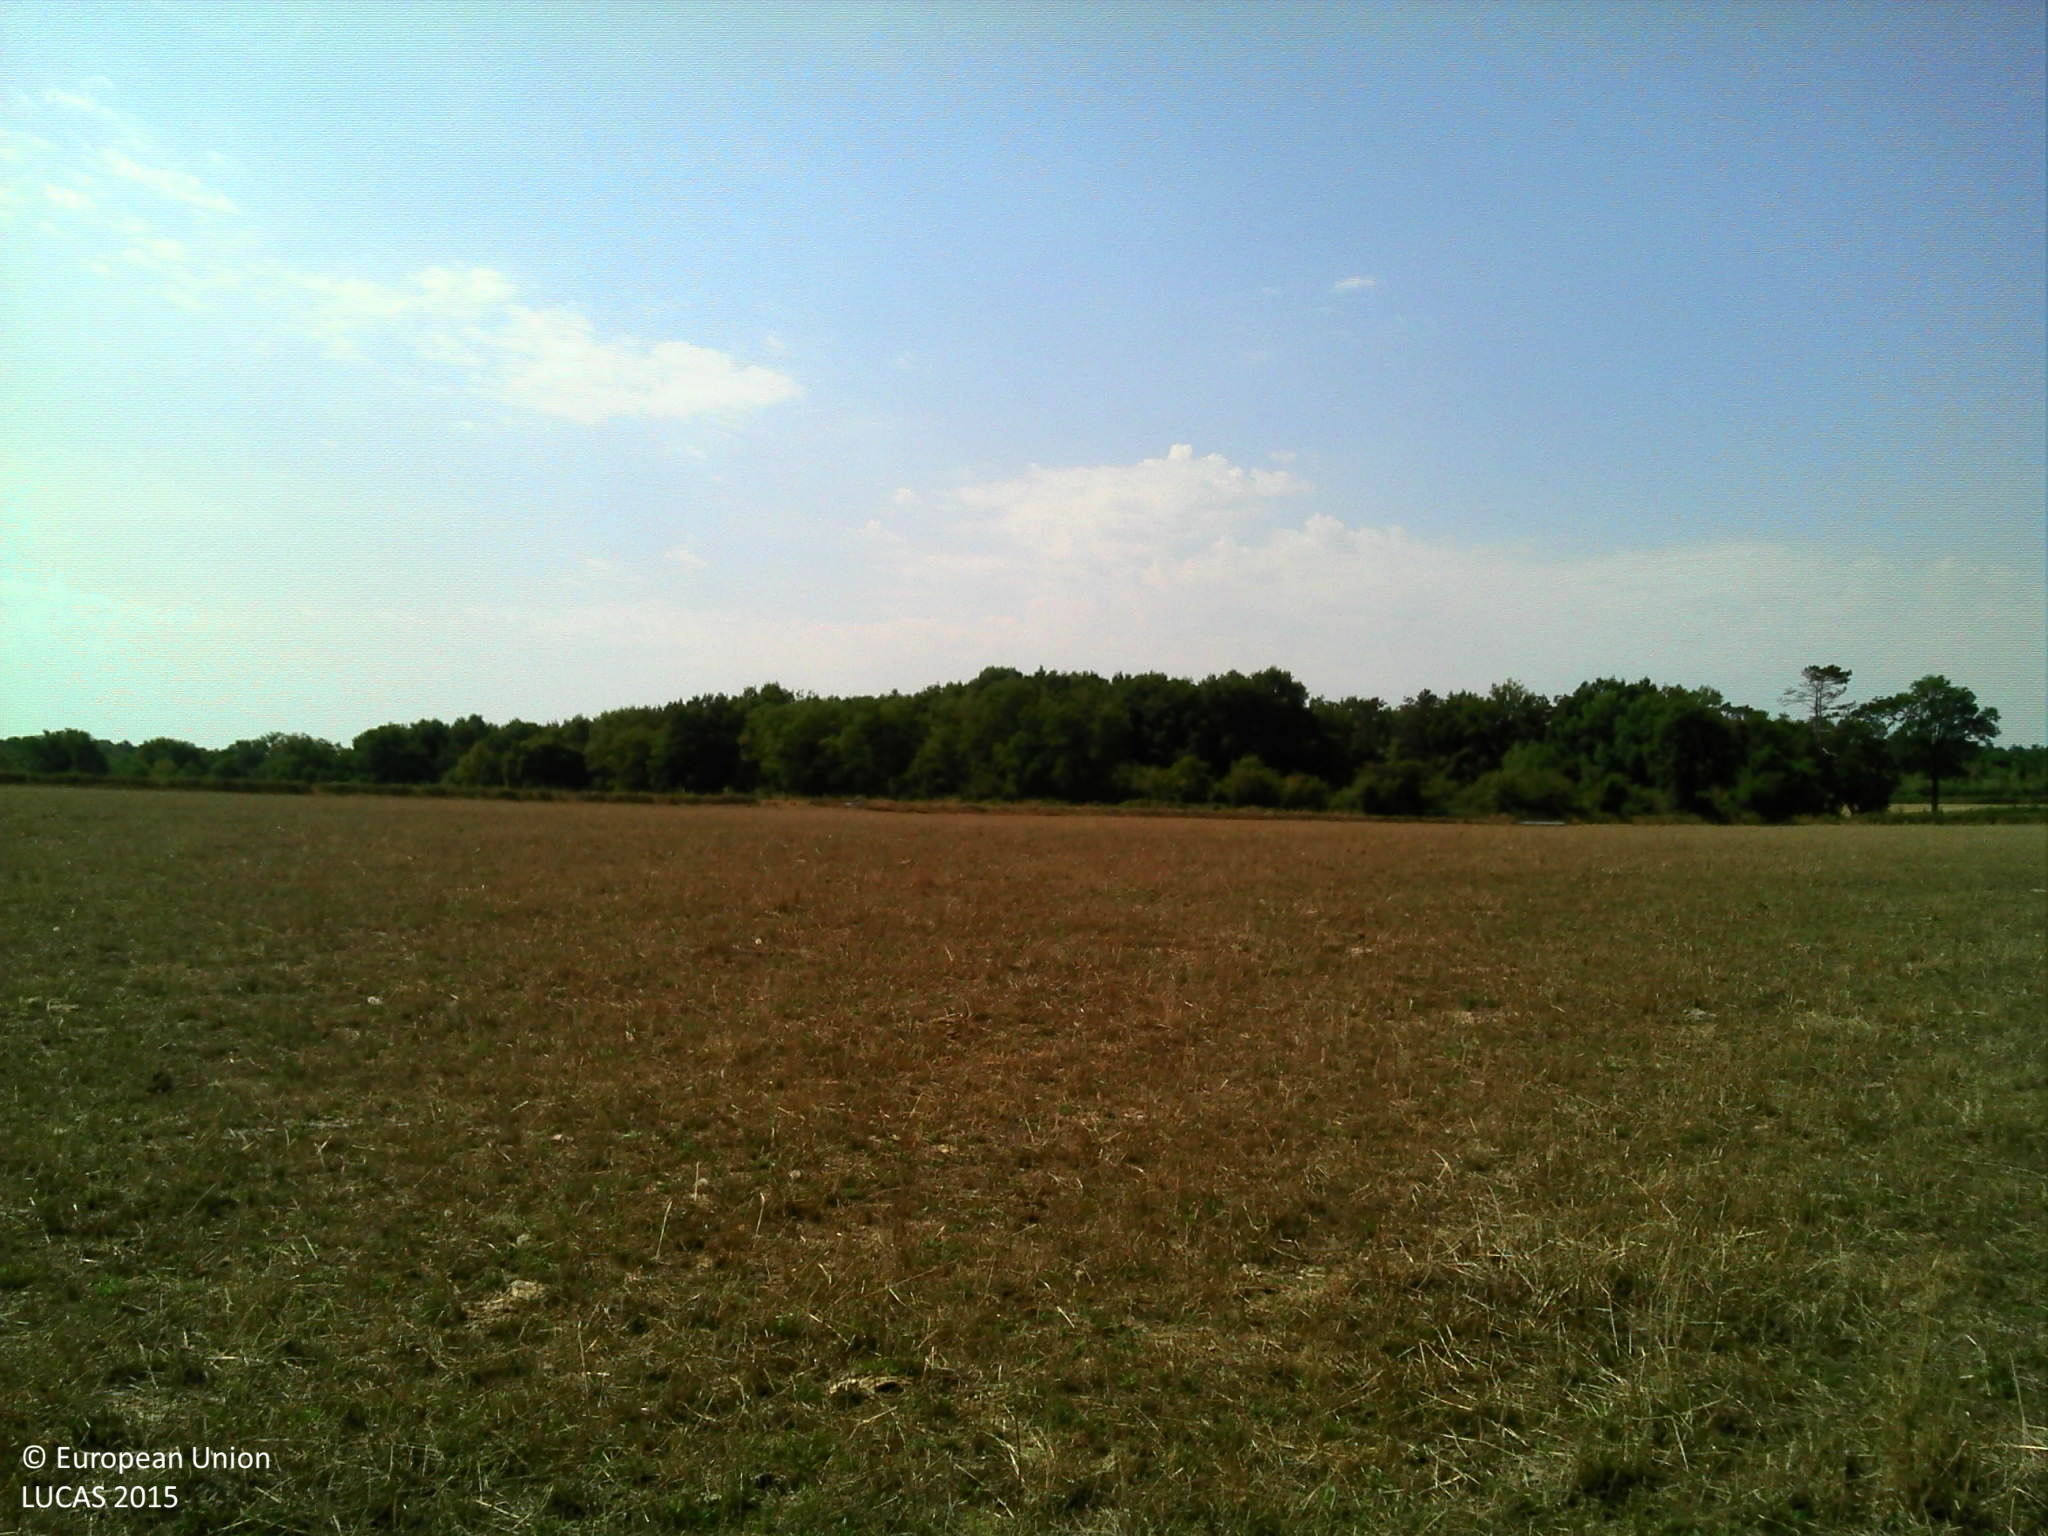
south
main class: Cropland
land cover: Temporary grasslands
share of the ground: > 75 %
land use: Agriculture (excluding fallow land and kitchen gardens)
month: August
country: FR
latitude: 46.6967
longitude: 2.9476
